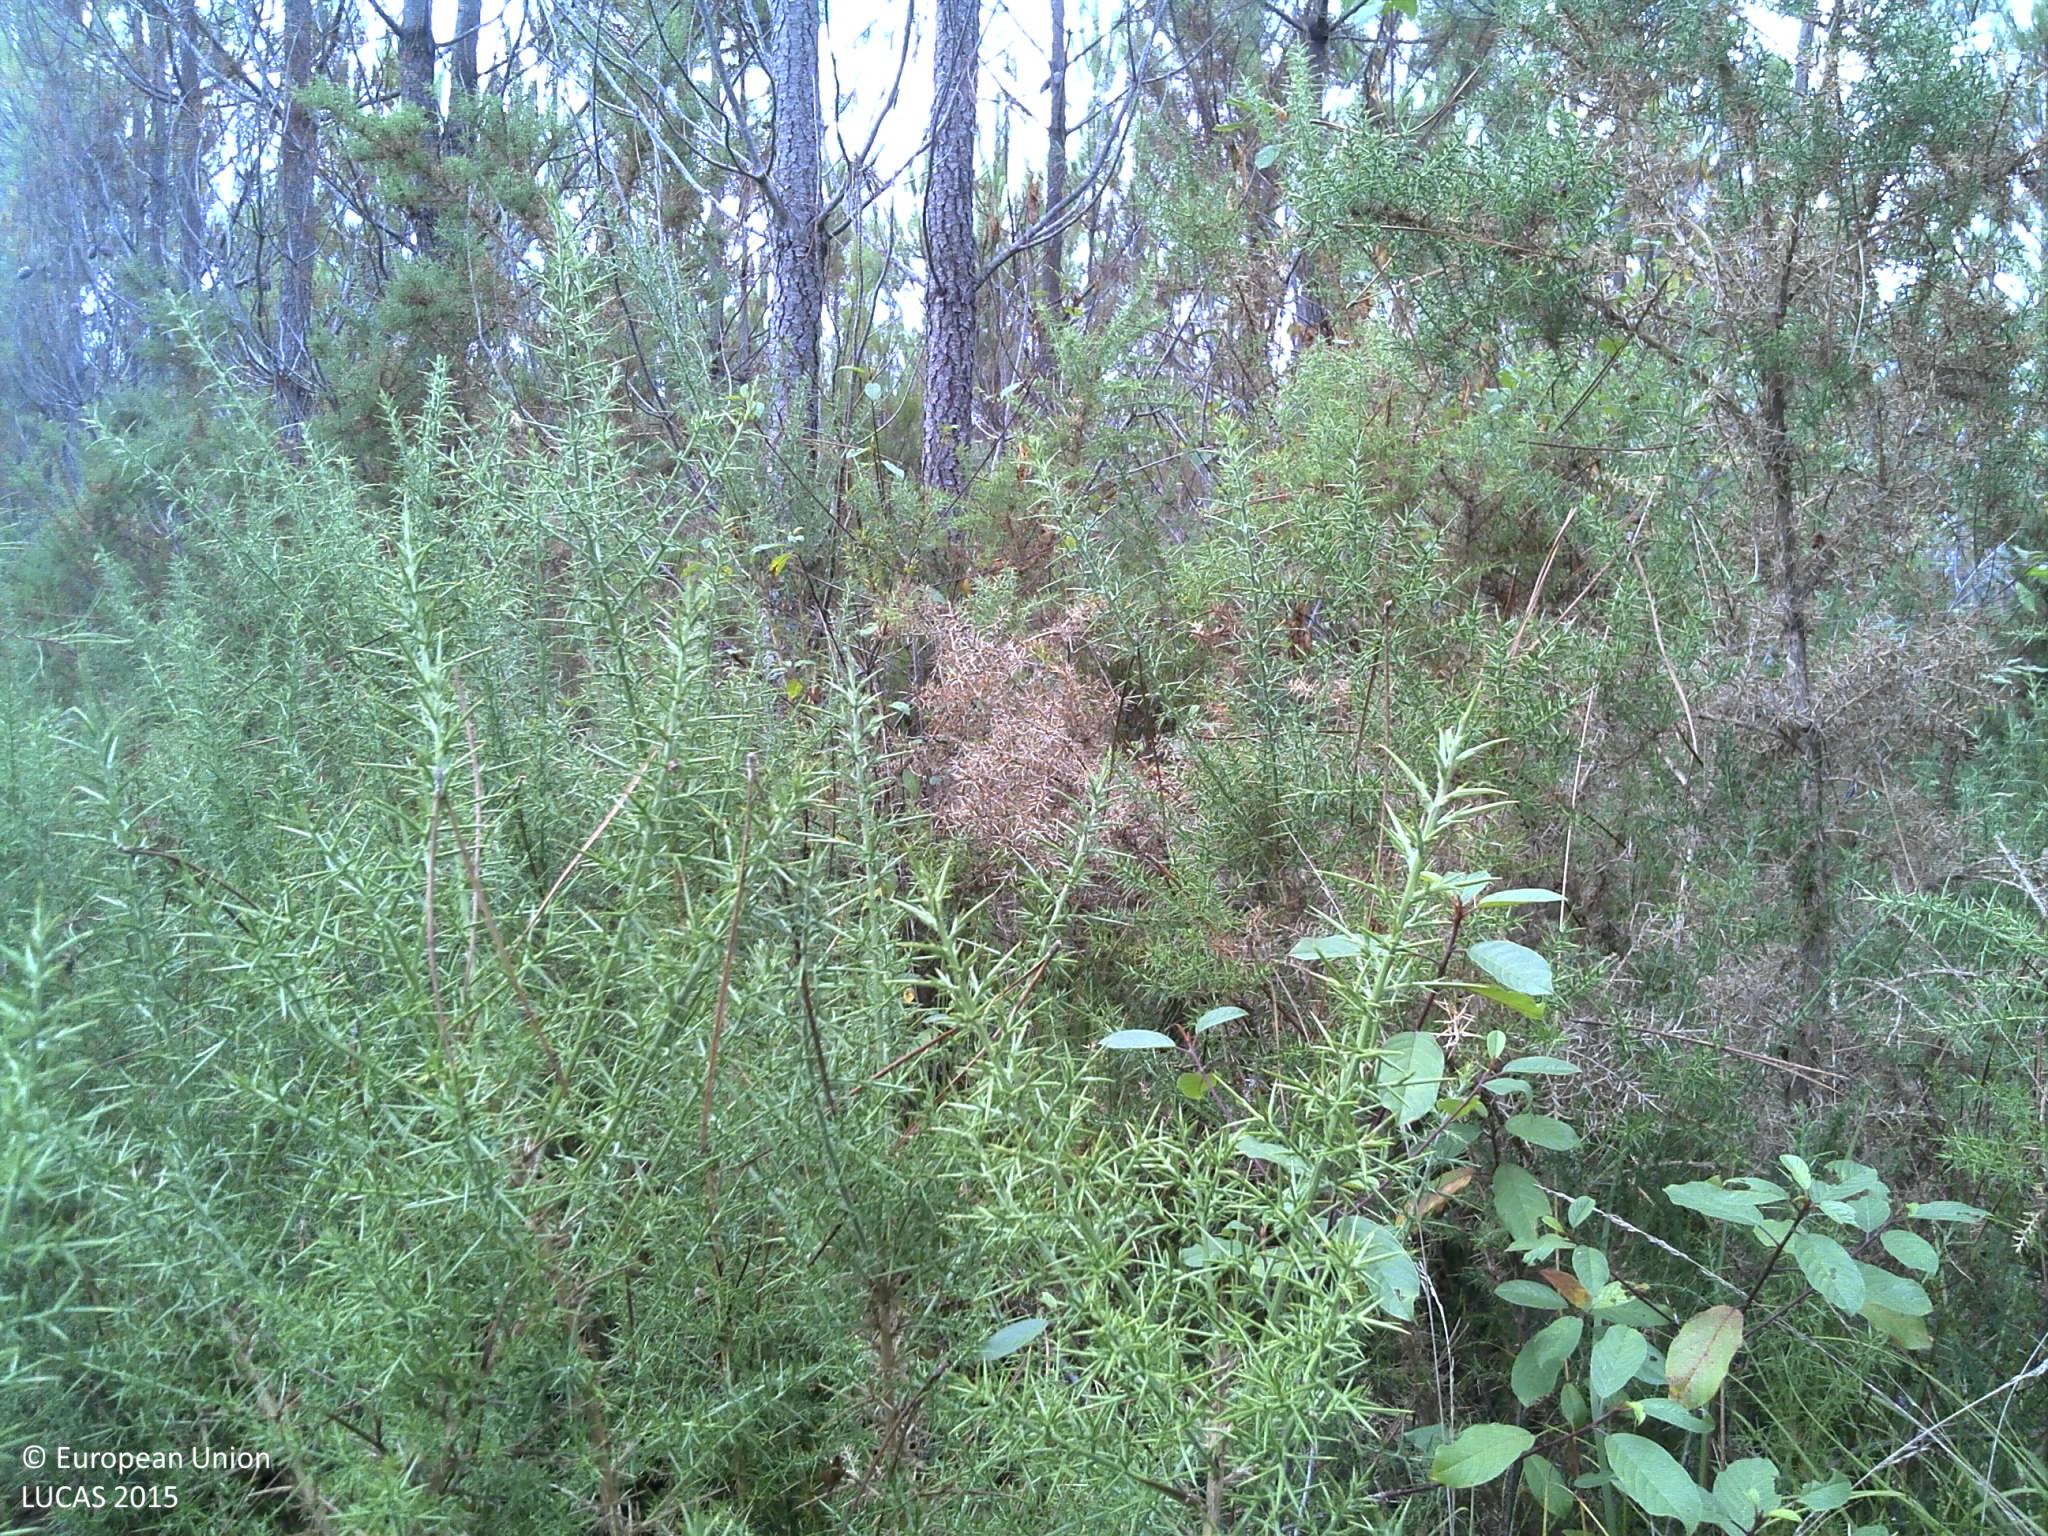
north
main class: Woodland
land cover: Pine dominated coniferous woodland
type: coniferous forest of the mediterranean region
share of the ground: > 75 %
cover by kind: coniferous forest trees 60 %, shrubs 30 %, herbaceous plants 5 %, lichens and mosses 5 %
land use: Forestry
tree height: > 5 m
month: August
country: FR
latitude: 44.6625
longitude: -0.9303
